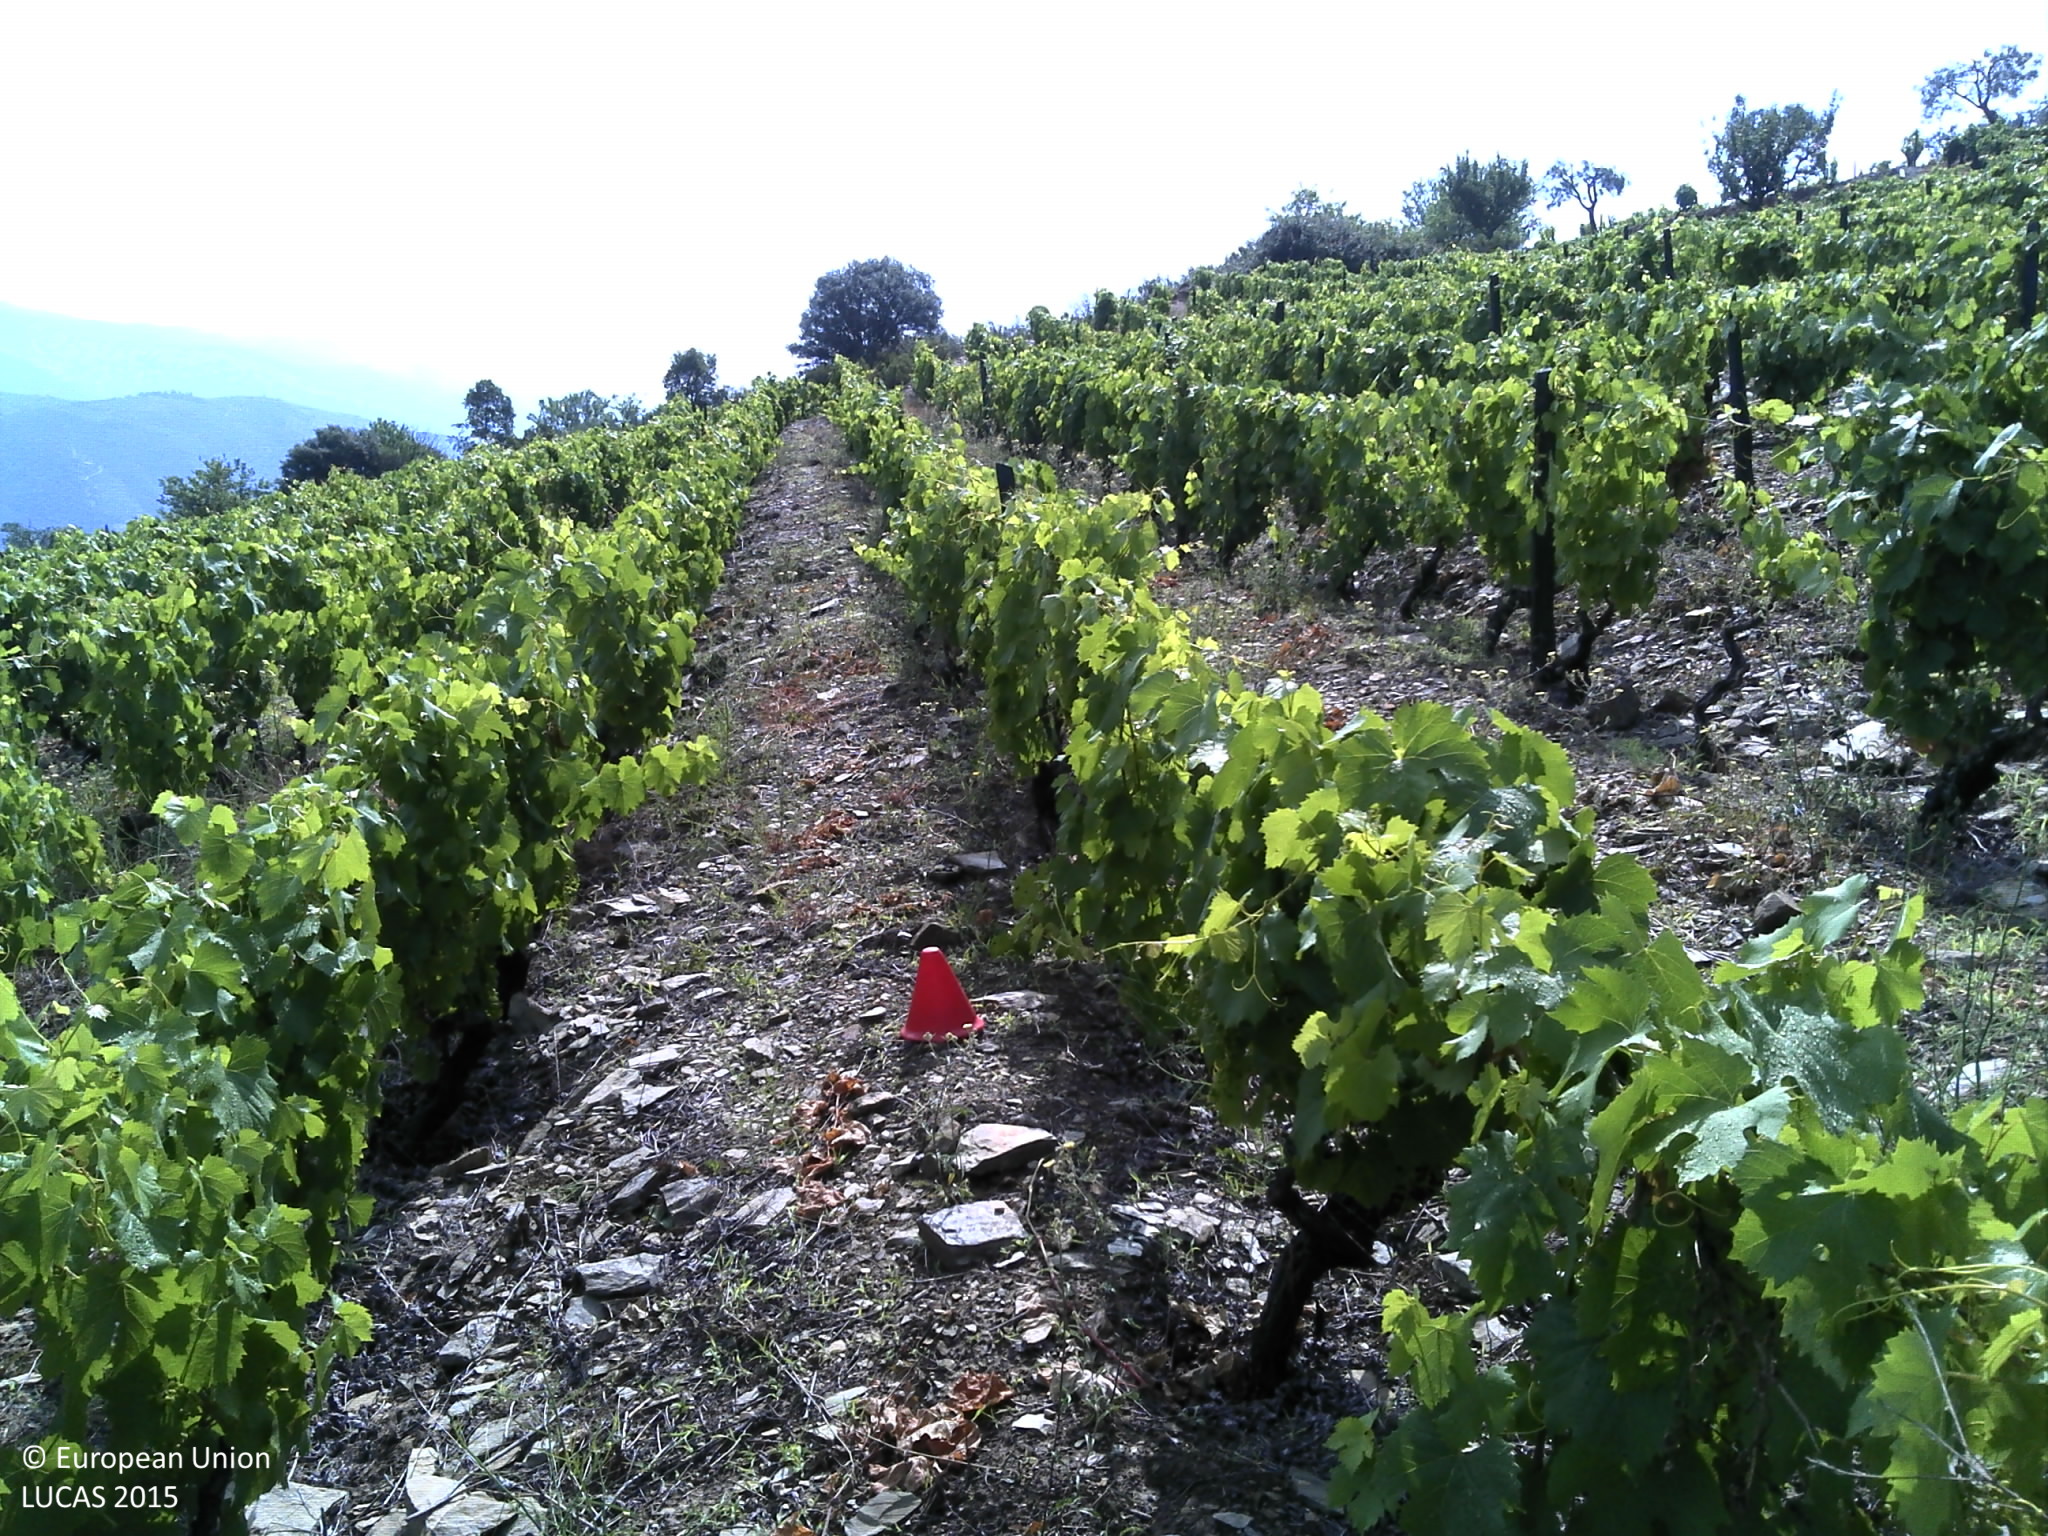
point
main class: Cropland
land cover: Vineyards
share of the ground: 10 - 25 %
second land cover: Spontaneously vegetated surfaces
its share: < 10 %
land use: Agriculture (excluding fallow land and kitchen gardens)
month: June
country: PT
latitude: 41.1912
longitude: -7.4940
